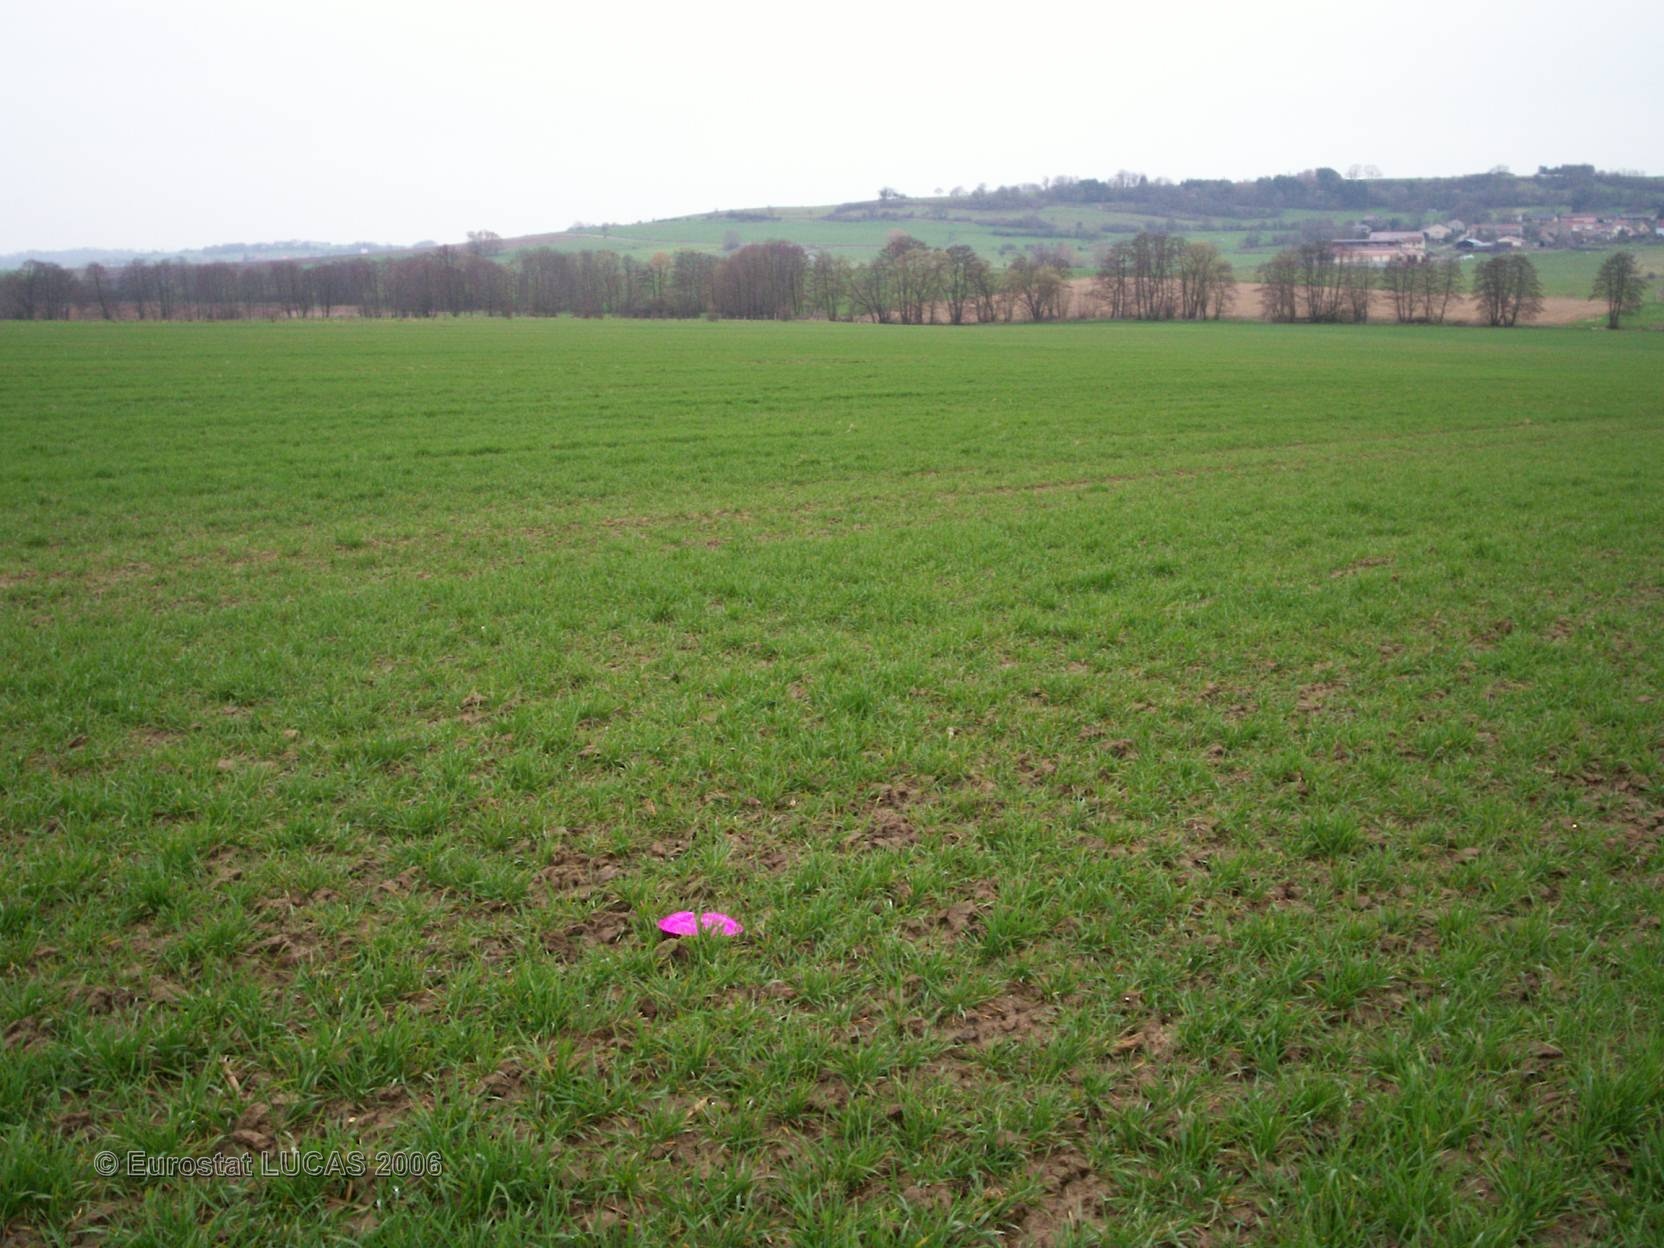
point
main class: Cropland
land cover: Common wheat
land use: Agriculture (excluding fallow land and kitchen gardens)
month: April
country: FR
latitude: 48.6329
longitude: 7.0018
